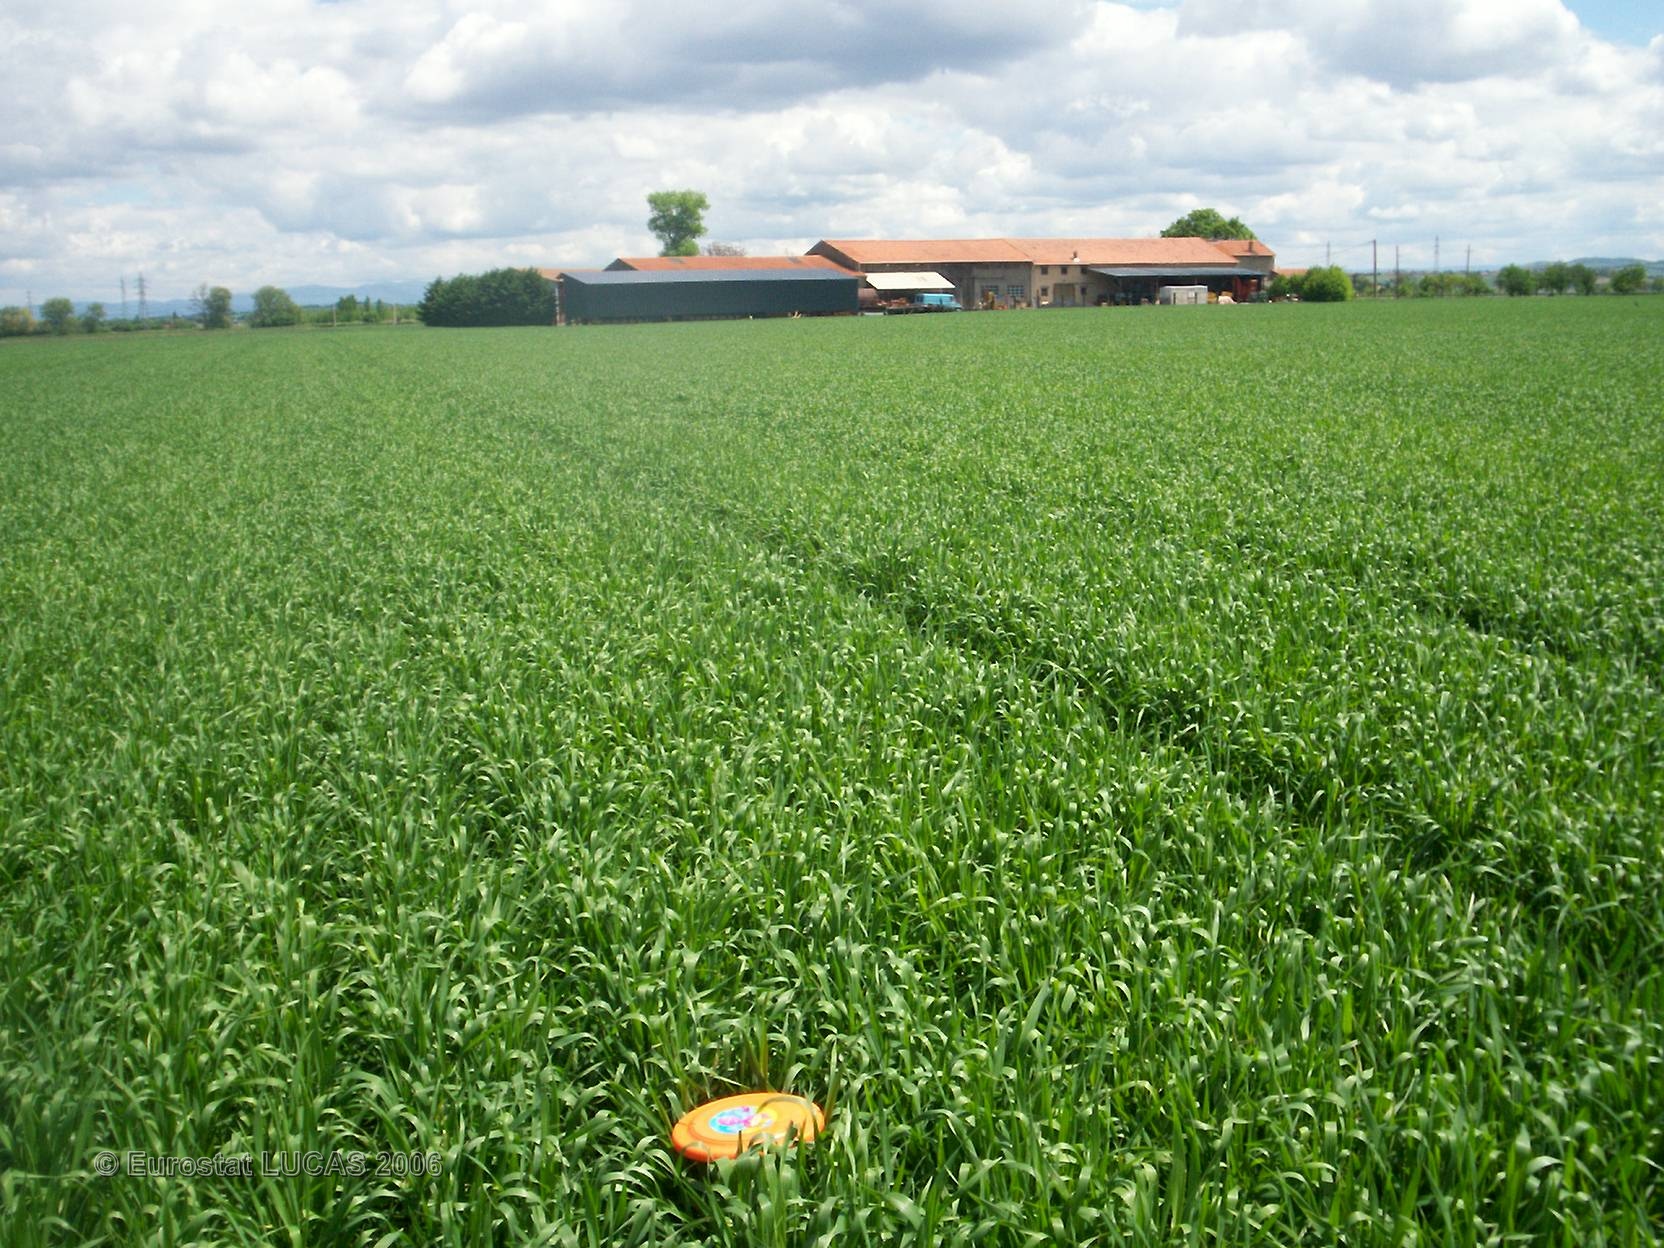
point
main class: Cropland
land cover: Common wheat
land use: Agriculture (excluding fallow land and kitchen gardens)
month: May
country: FR
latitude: 45.8268
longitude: 3.1904
